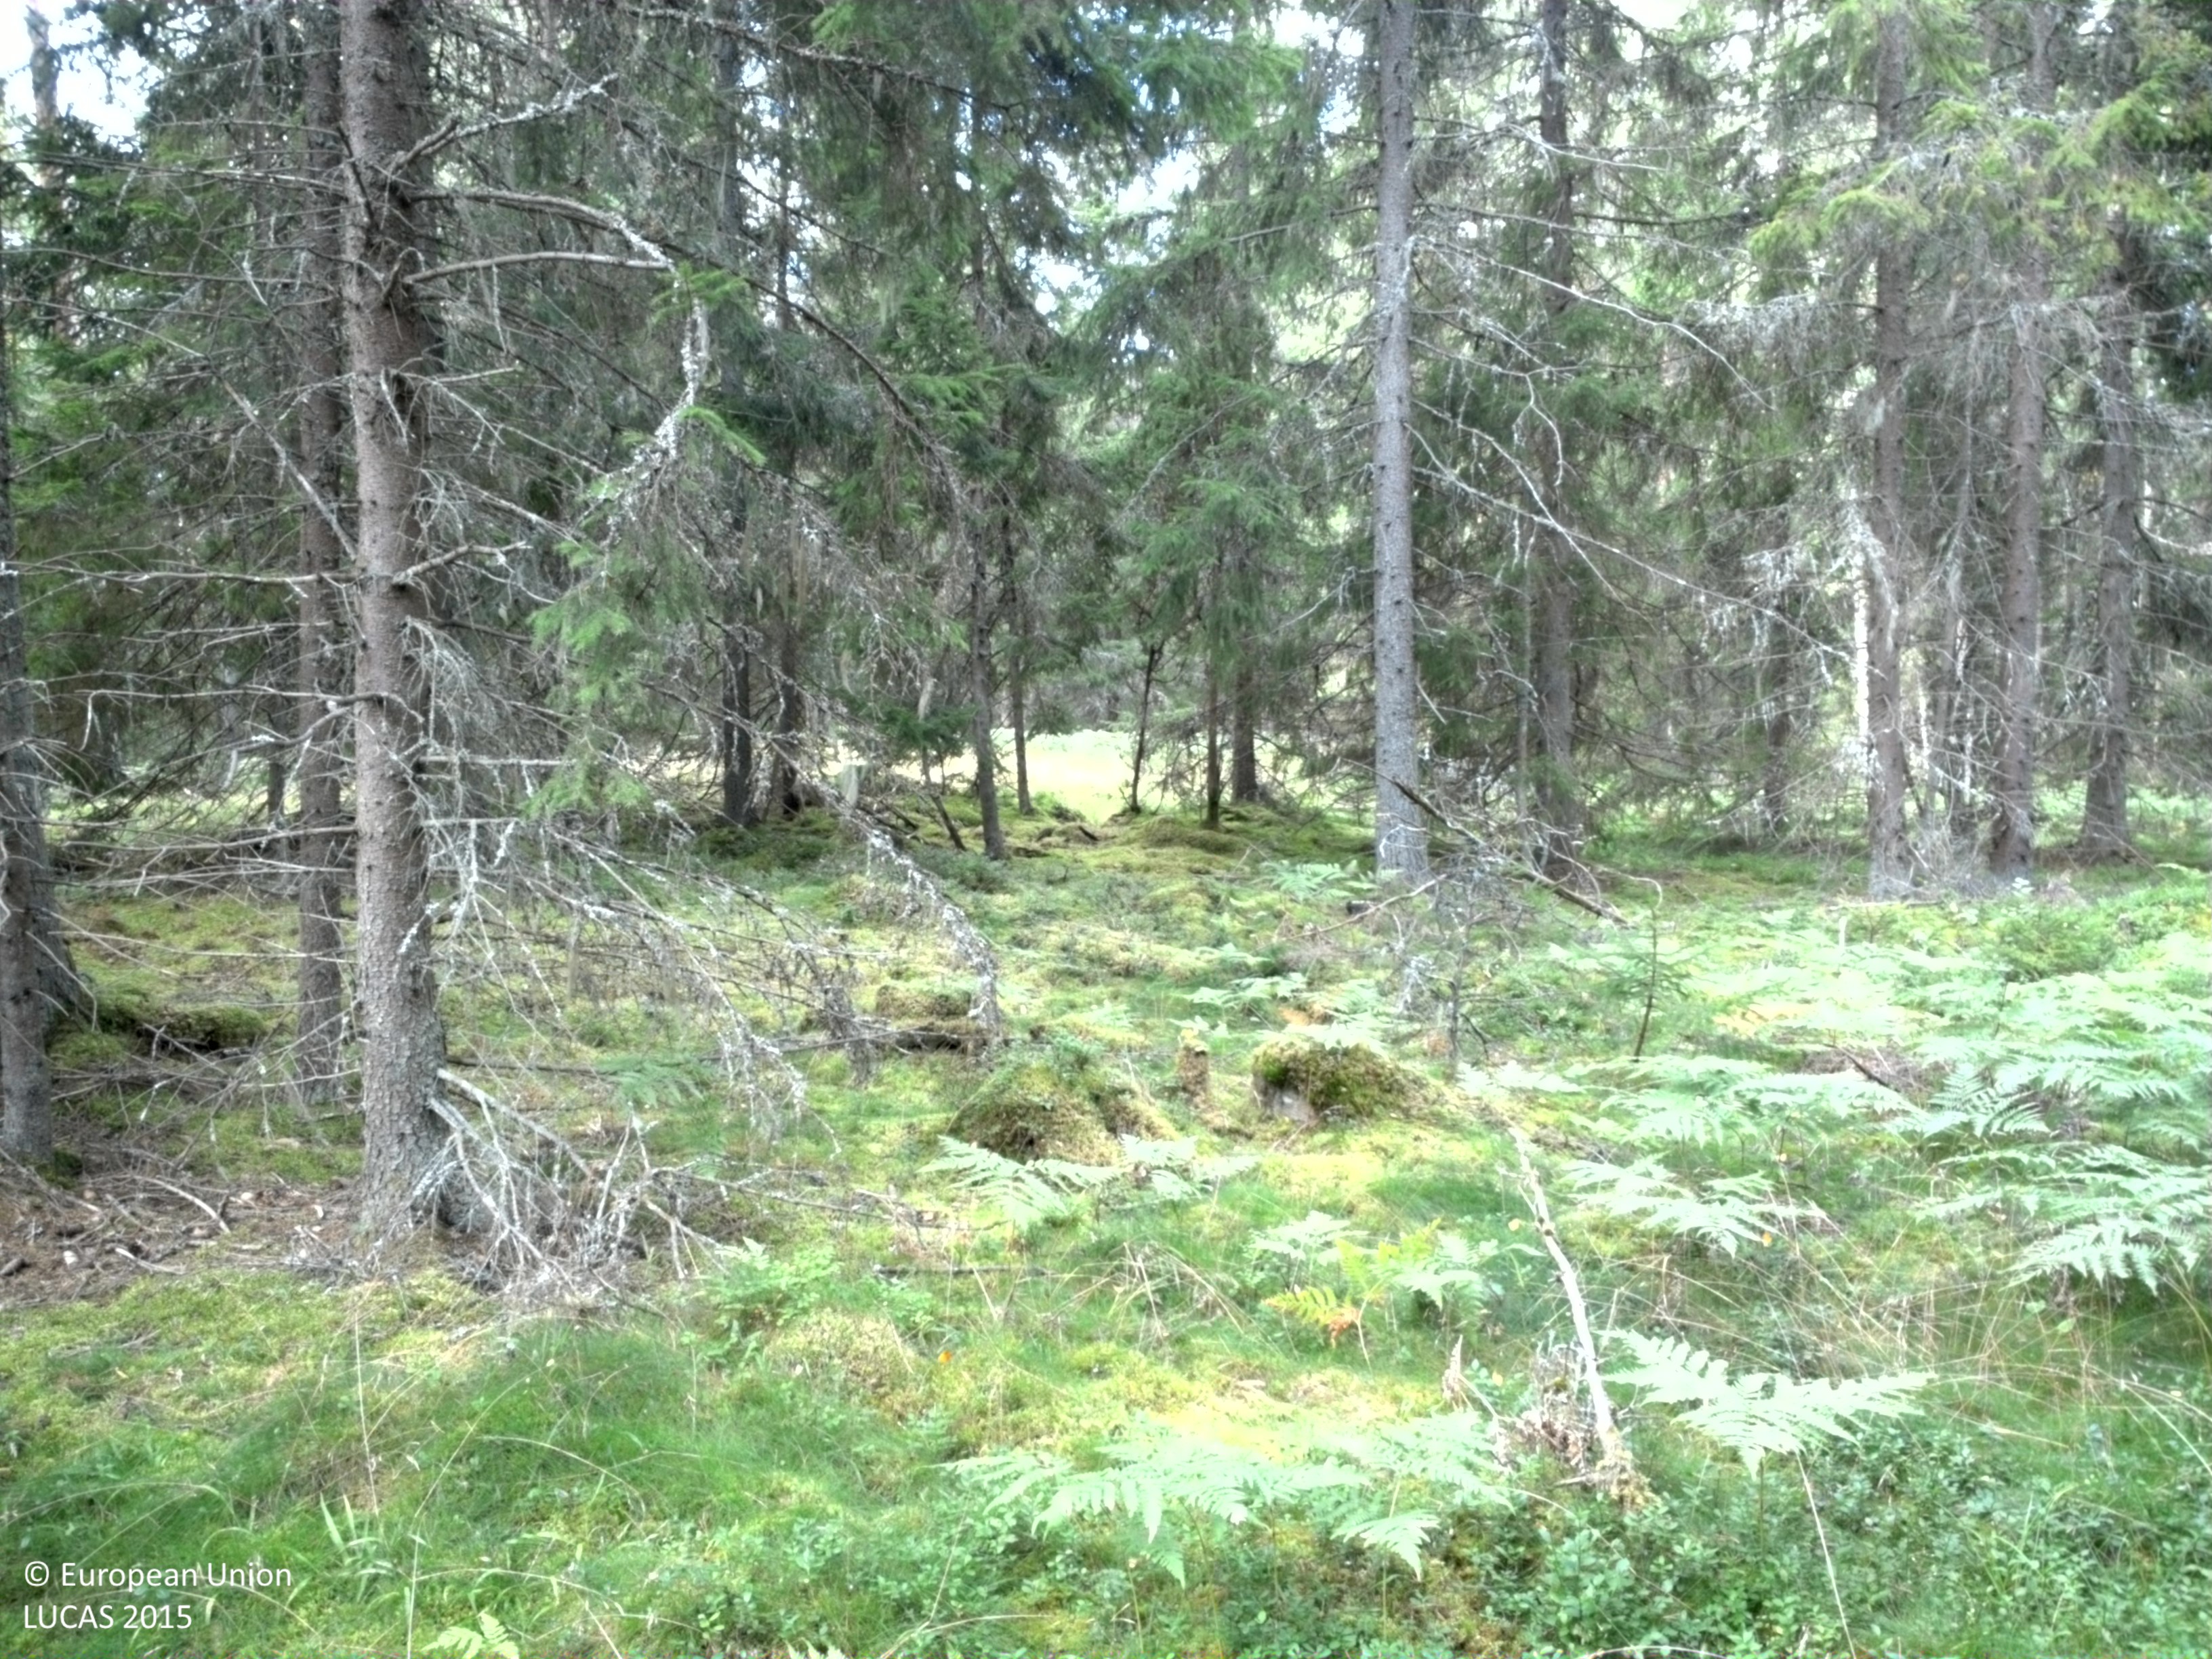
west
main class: Woodland
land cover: Spruce dominated coniferous woodland
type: boreal forest
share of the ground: > 75 %
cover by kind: coniferous forest trees 70 %, lichens and mosses 20 %, broadleaved forest trees 10 %
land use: Forestry
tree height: > 5 m
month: August
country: SE
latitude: 59.5826
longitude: 17.1655
